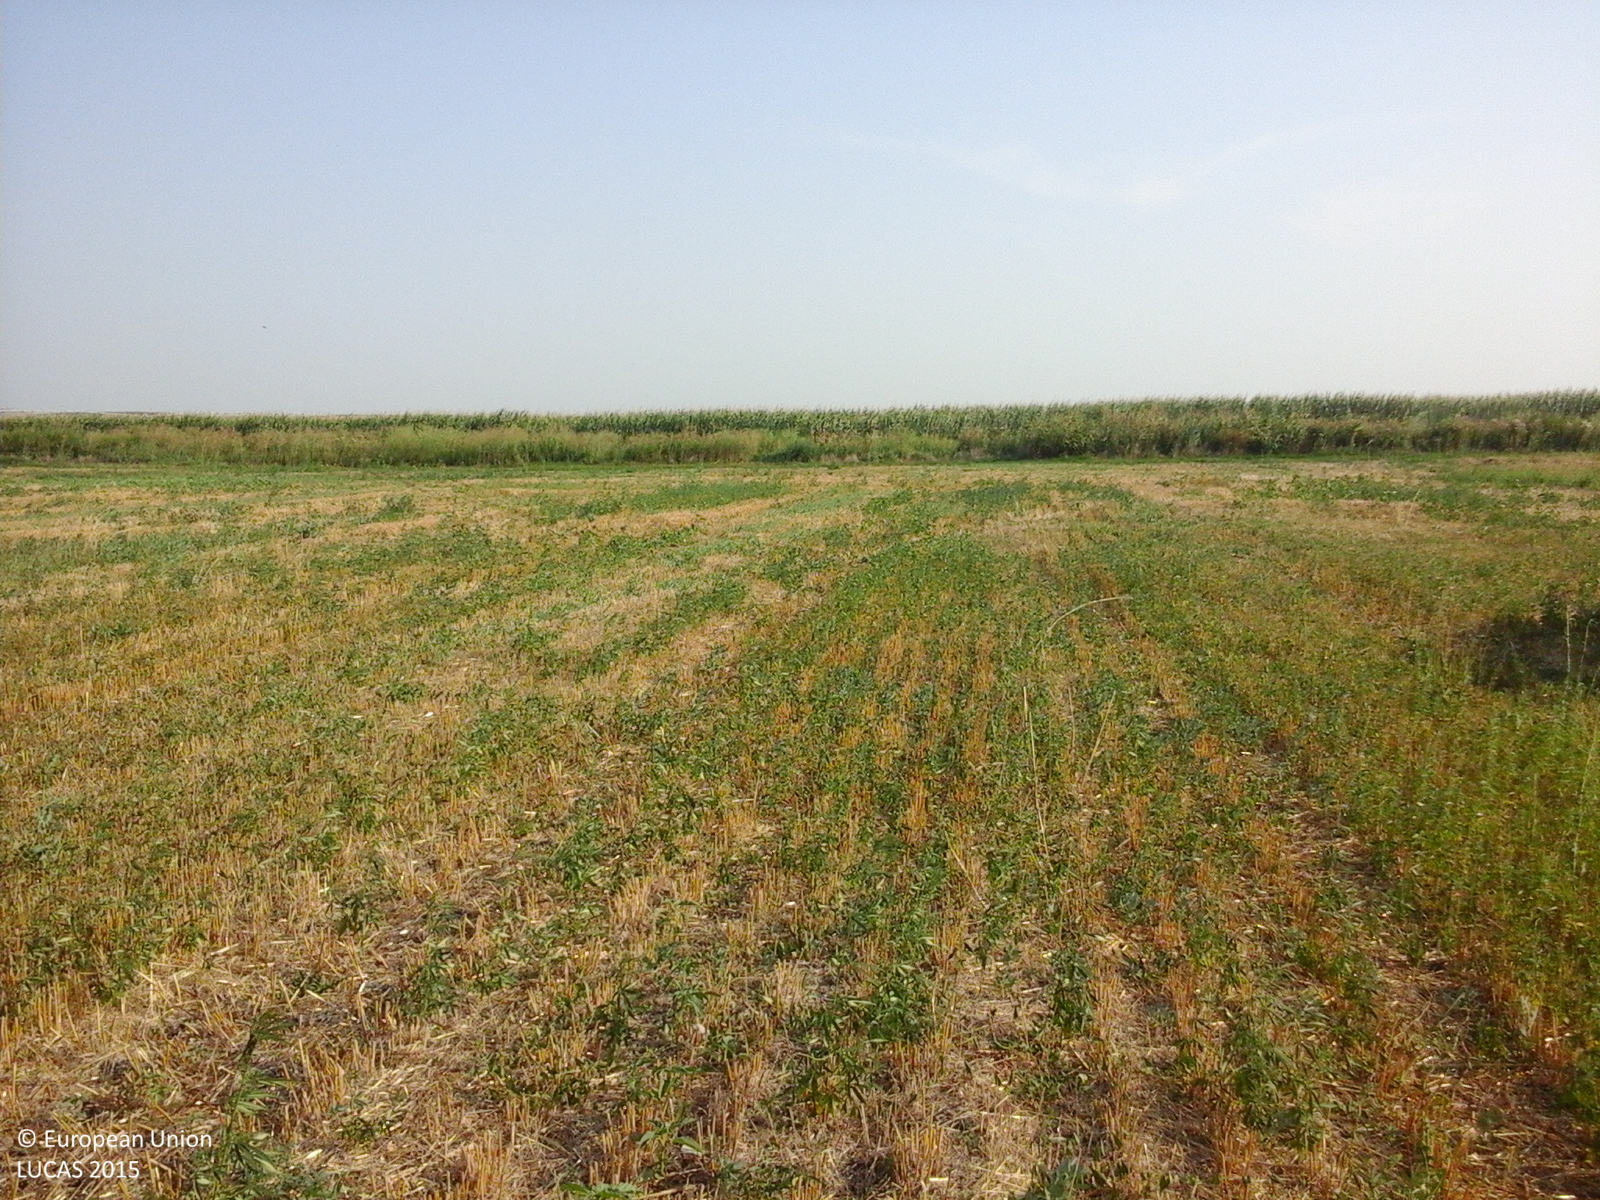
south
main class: Cropland
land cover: Barley
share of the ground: 50 - 75 %
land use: Agriculture (excluding fallow land and kitchen gardens)
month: August
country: RO
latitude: 44.9731
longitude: 28.1088
